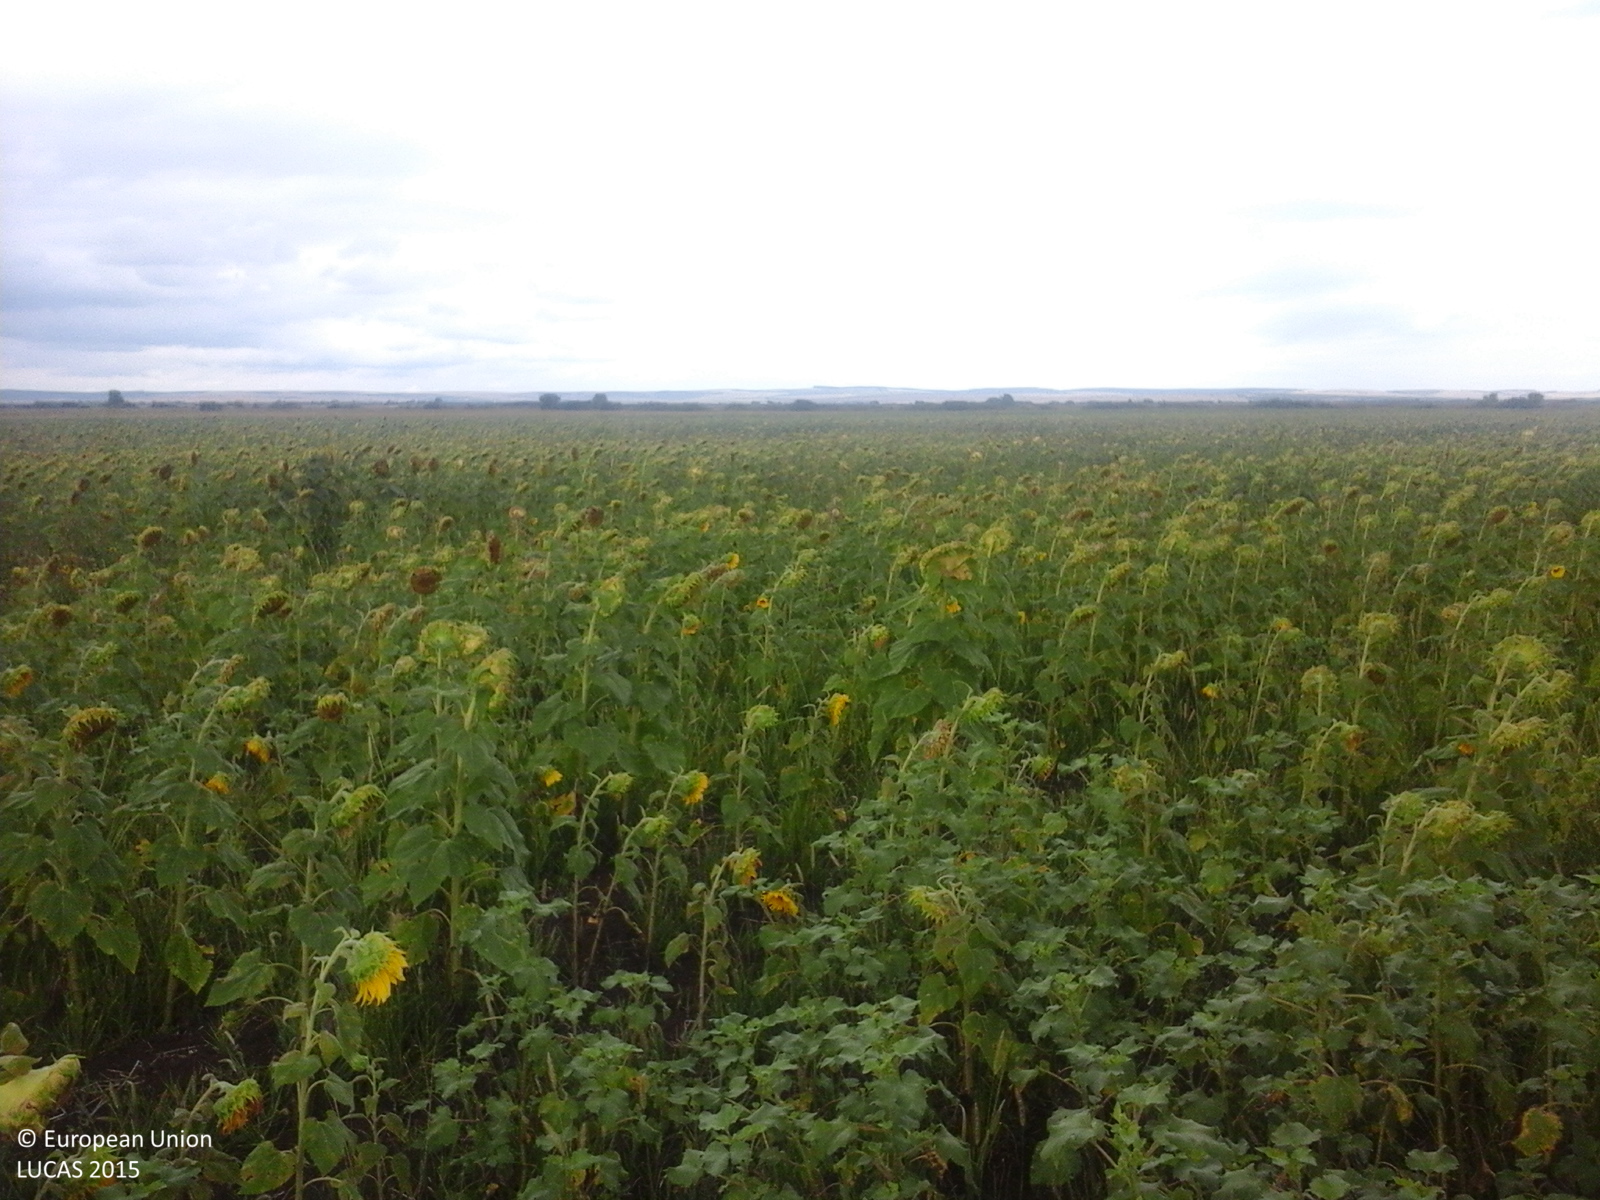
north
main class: Cropland
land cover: Sunflower
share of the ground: > 75 %
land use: Agriculture (excluding fallow land and kitchen gardens)
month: August
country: RO
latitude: 45.7372
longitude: 21.5884
